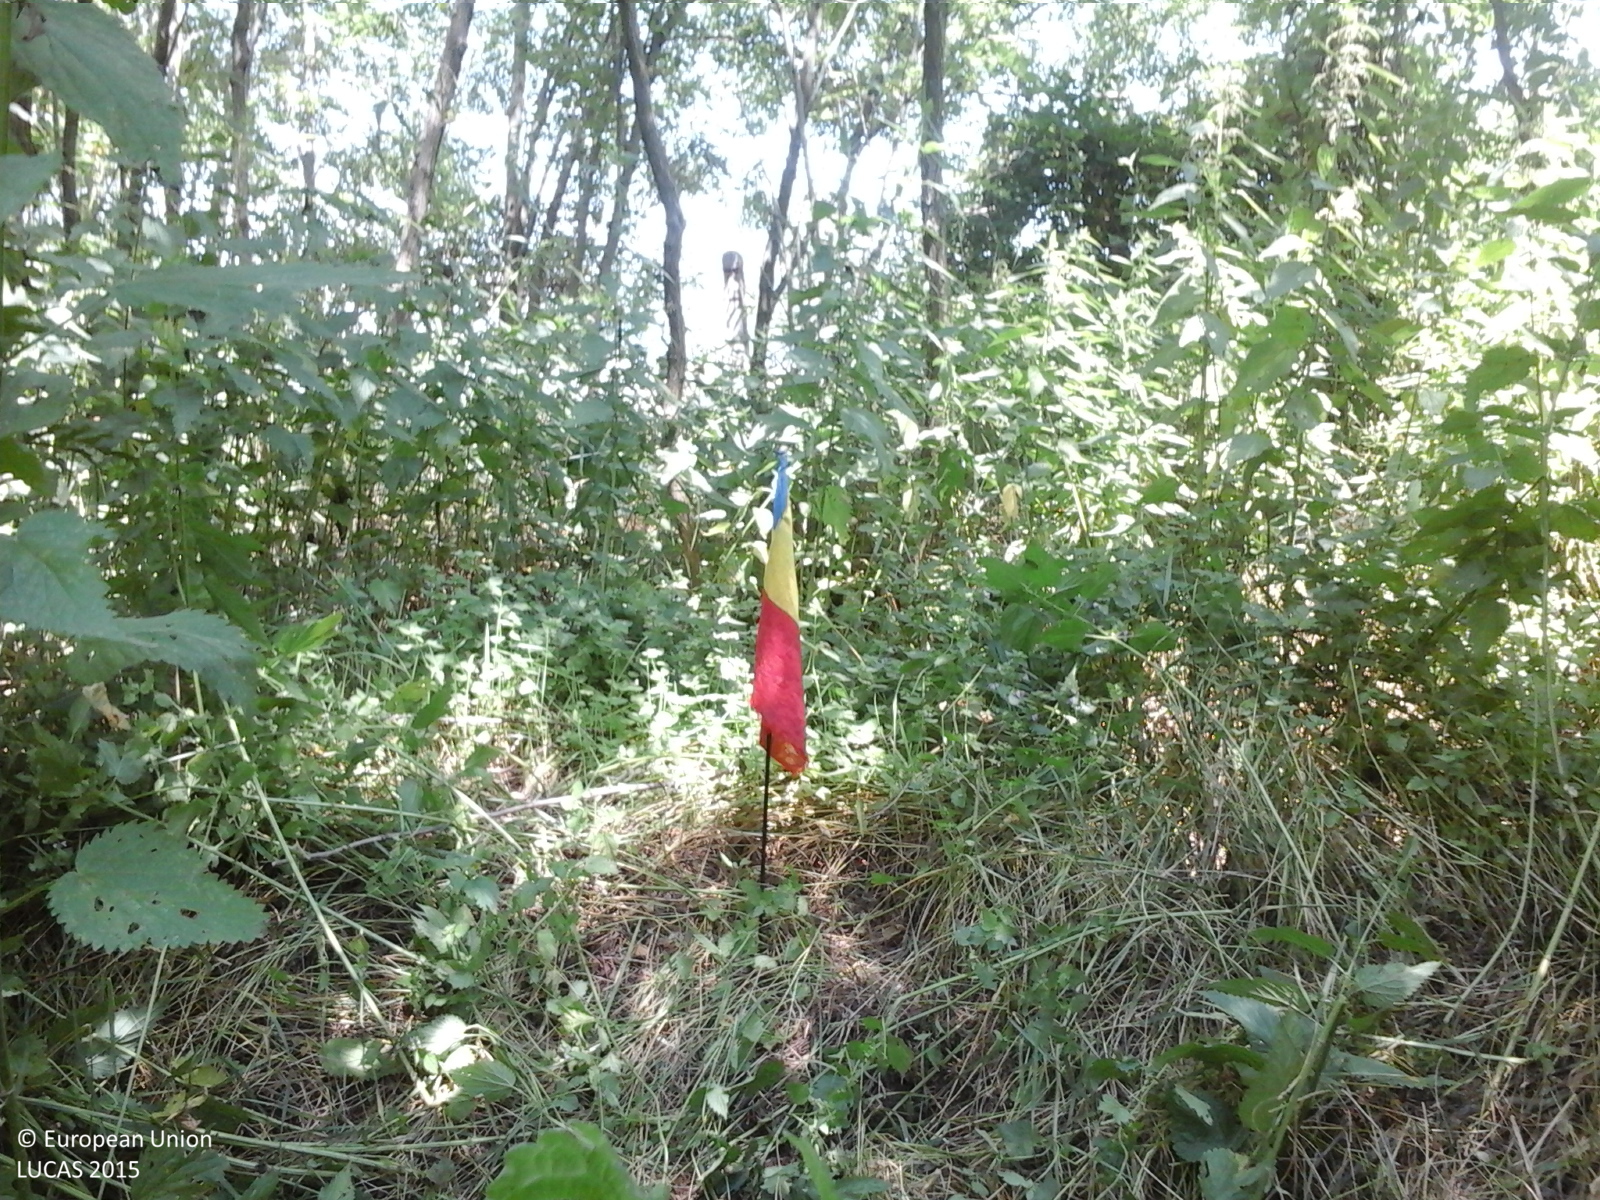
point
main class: Woodland
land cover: Broadleaved woodland
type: thermophilous deciduous forest
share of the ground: > 75 %
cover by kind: broadleaved forest trees 100 %
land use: Forestry
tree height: > 5 m
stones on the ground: < 10 %
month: July
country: RO
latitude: 44.7833
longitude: 24.5453
